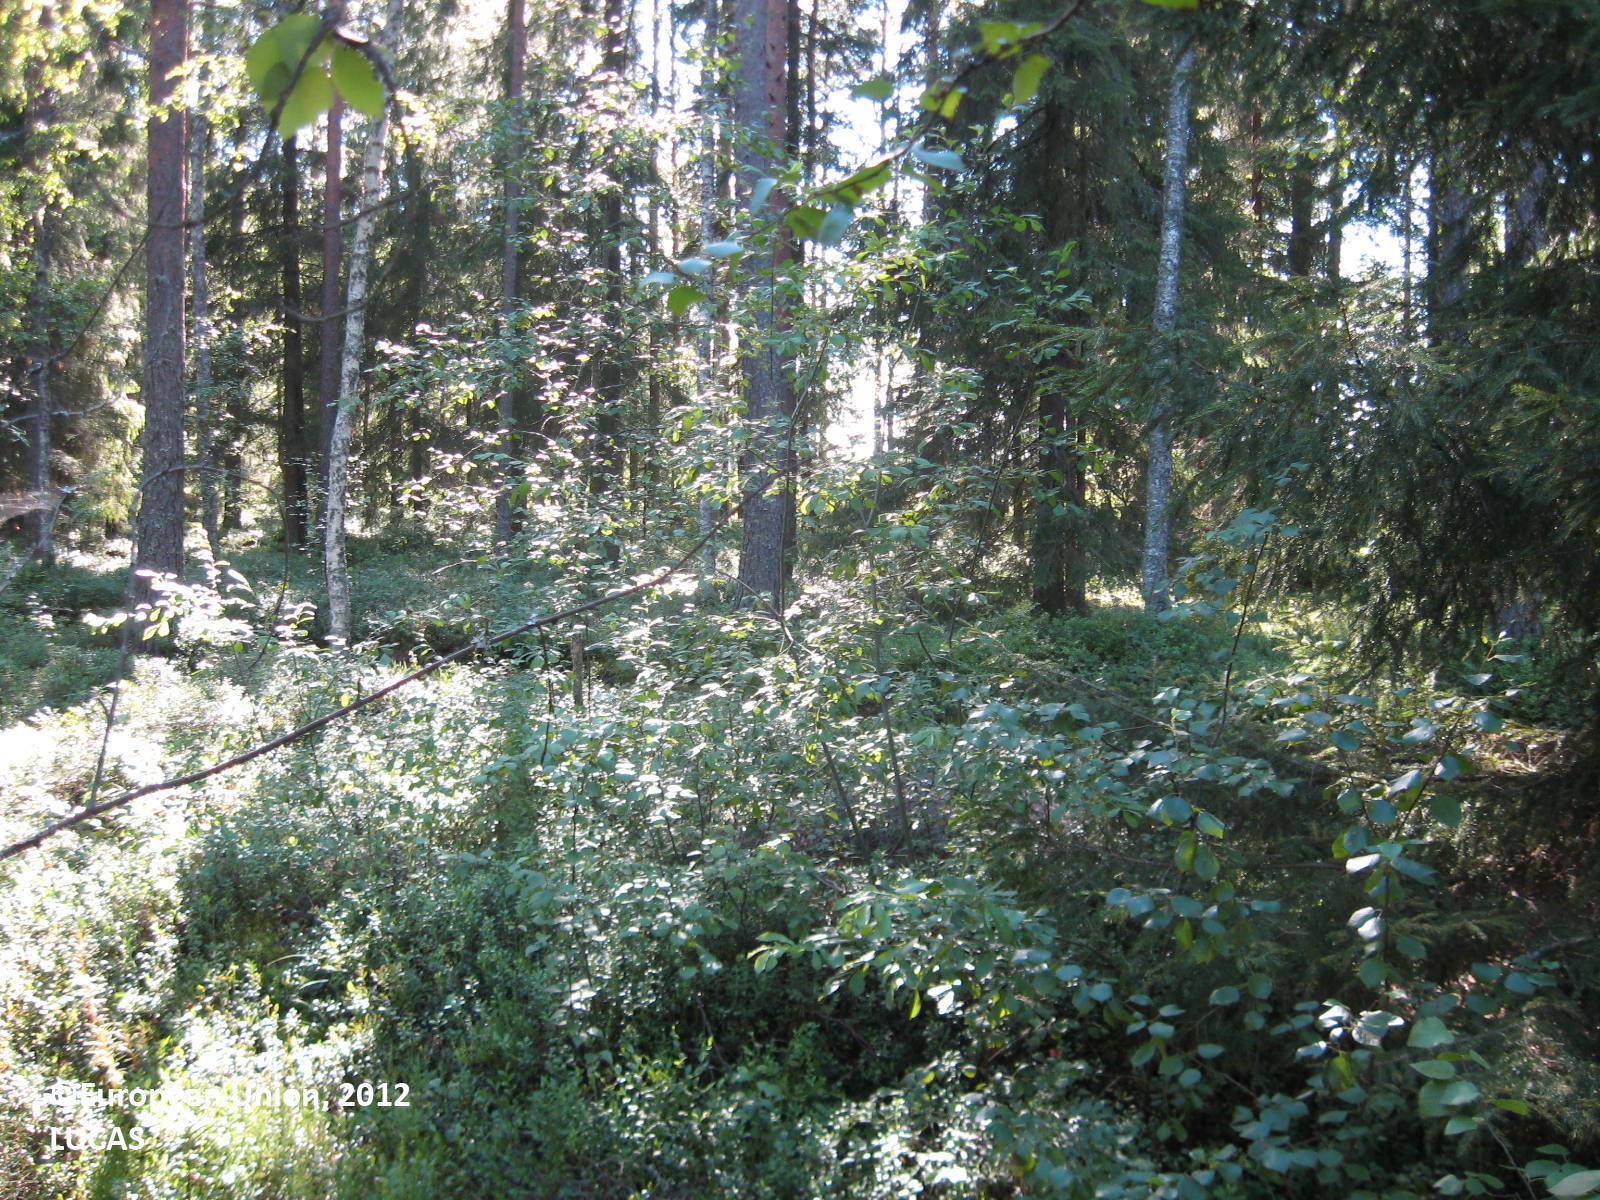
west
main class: Woodland
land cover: Pine dominated mixed woodland
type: boreal forest
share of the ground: > 75 %
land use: Forestry
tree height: > 5 m
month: July
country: FI
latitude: 62.0579
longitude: 22.4355
